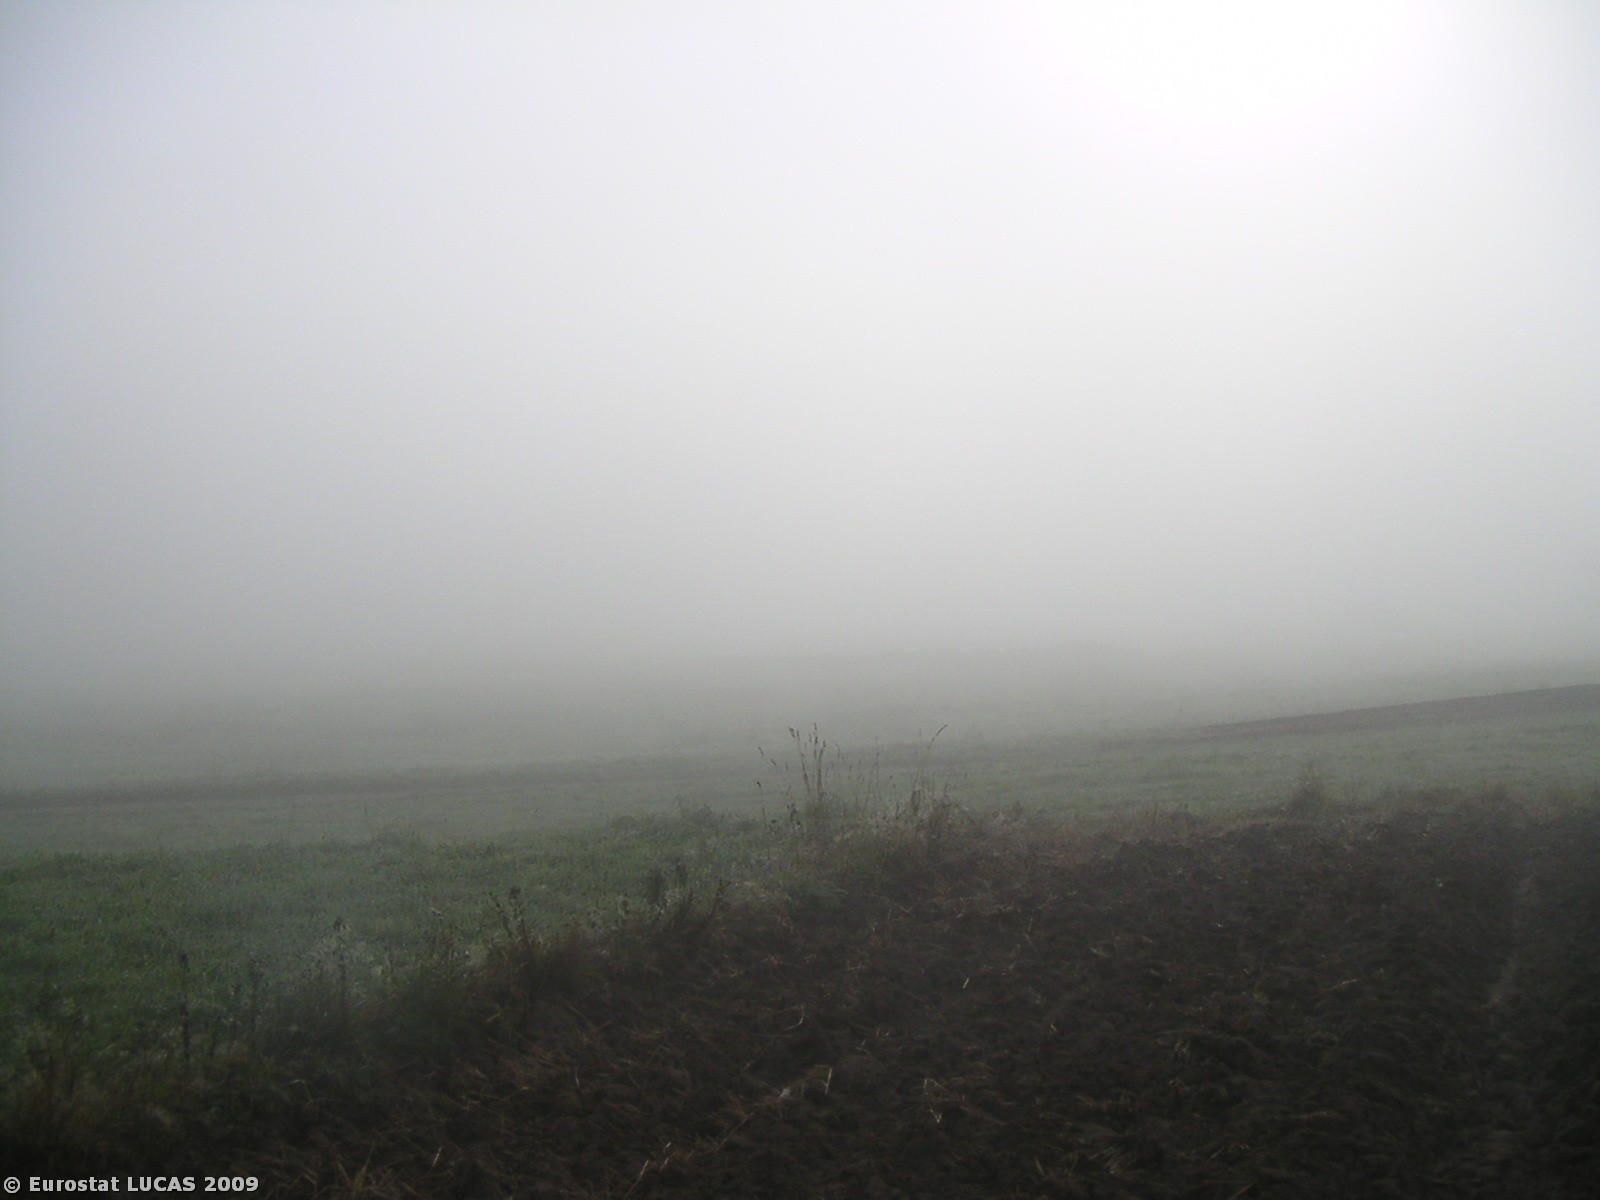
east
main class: Cropland
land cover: Oats
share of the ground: < 10 %
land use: Agriculture (excluding fallow land and kitchen gardens)
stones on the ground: 10 - 25 %
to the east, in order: Oats; Grassland without tree/shrub cover; Tracks; Grassland without tree/shrub cover; Spontaneously vegetated surfaces; Grassland without tree/shrub cover; Spontaneously vegetated surfaces
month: September
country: PL
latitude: 49.5008
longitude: 19.8755
